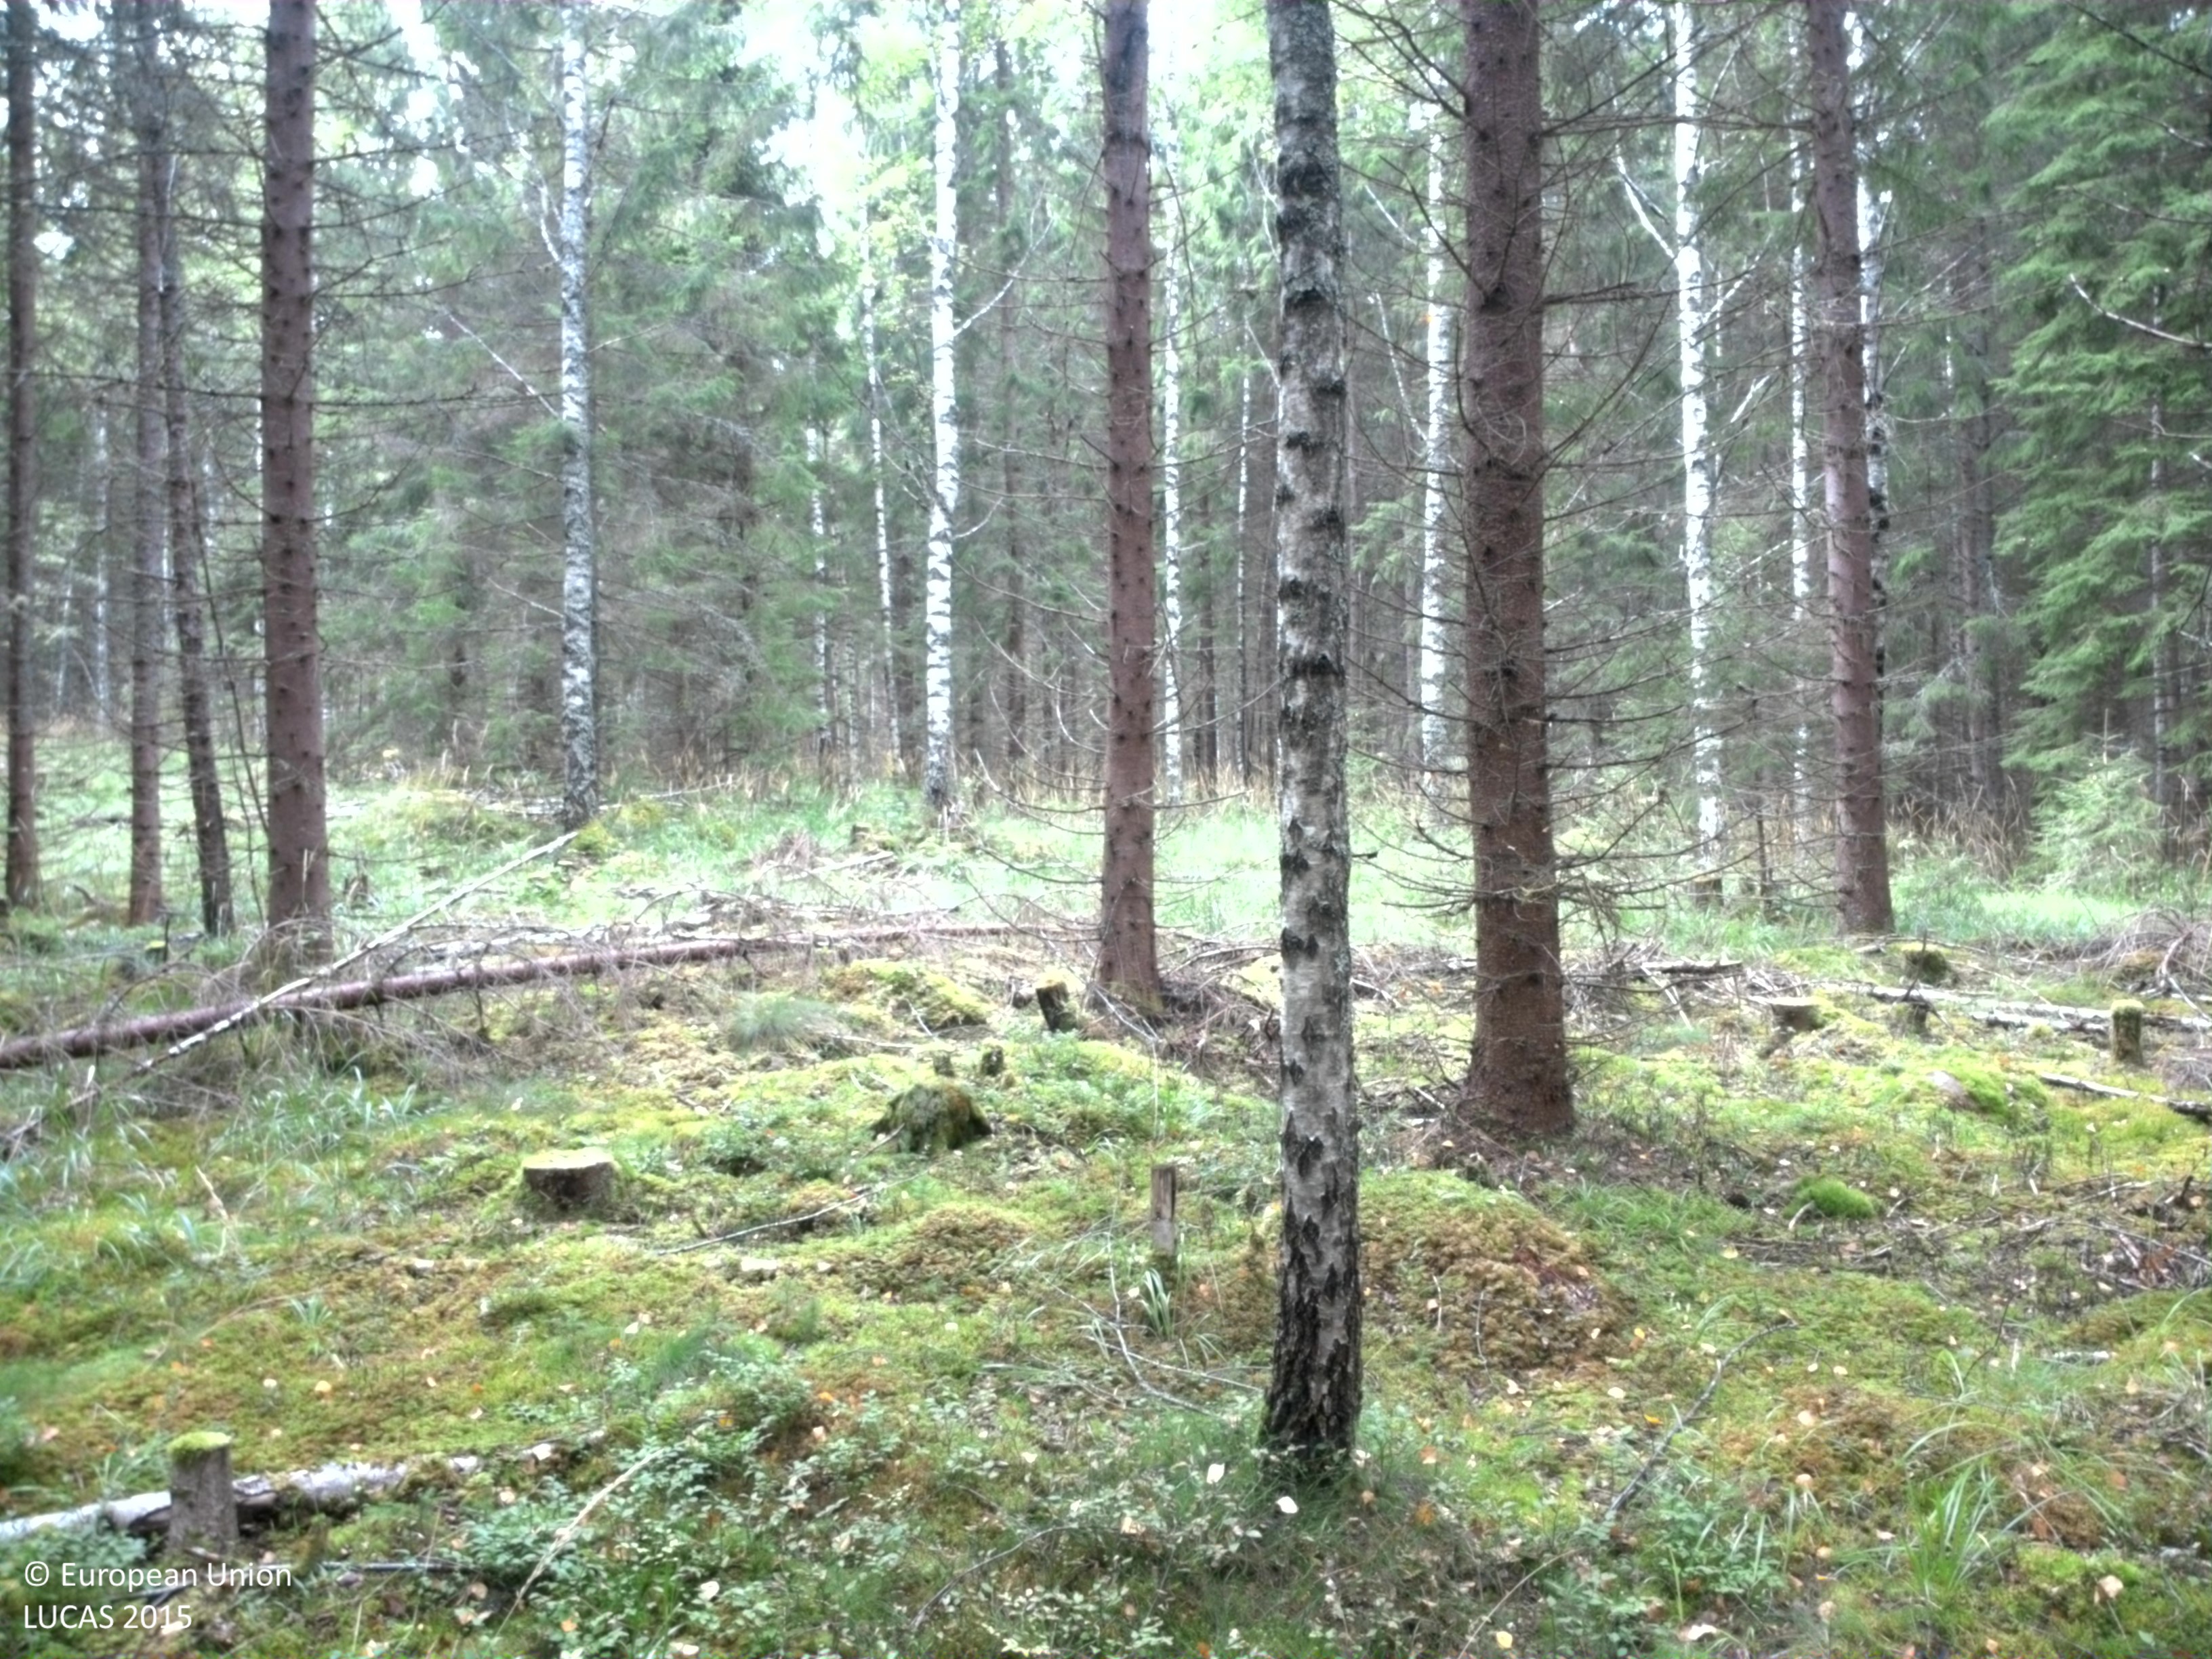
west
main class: Woodland
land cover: Spruce dominated coniferous woodland
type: boreal forest
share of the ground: 50 - 75 %
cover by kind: coniferous forest trees 65 %, lichens and mosses 20 %, broadleaved forest trees 5 %, shrubs 5 %, herbaceous plants 5 %
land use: Forestry
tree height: > 5 m
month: August
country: SE
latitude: 59.6717
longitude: 13.3828
